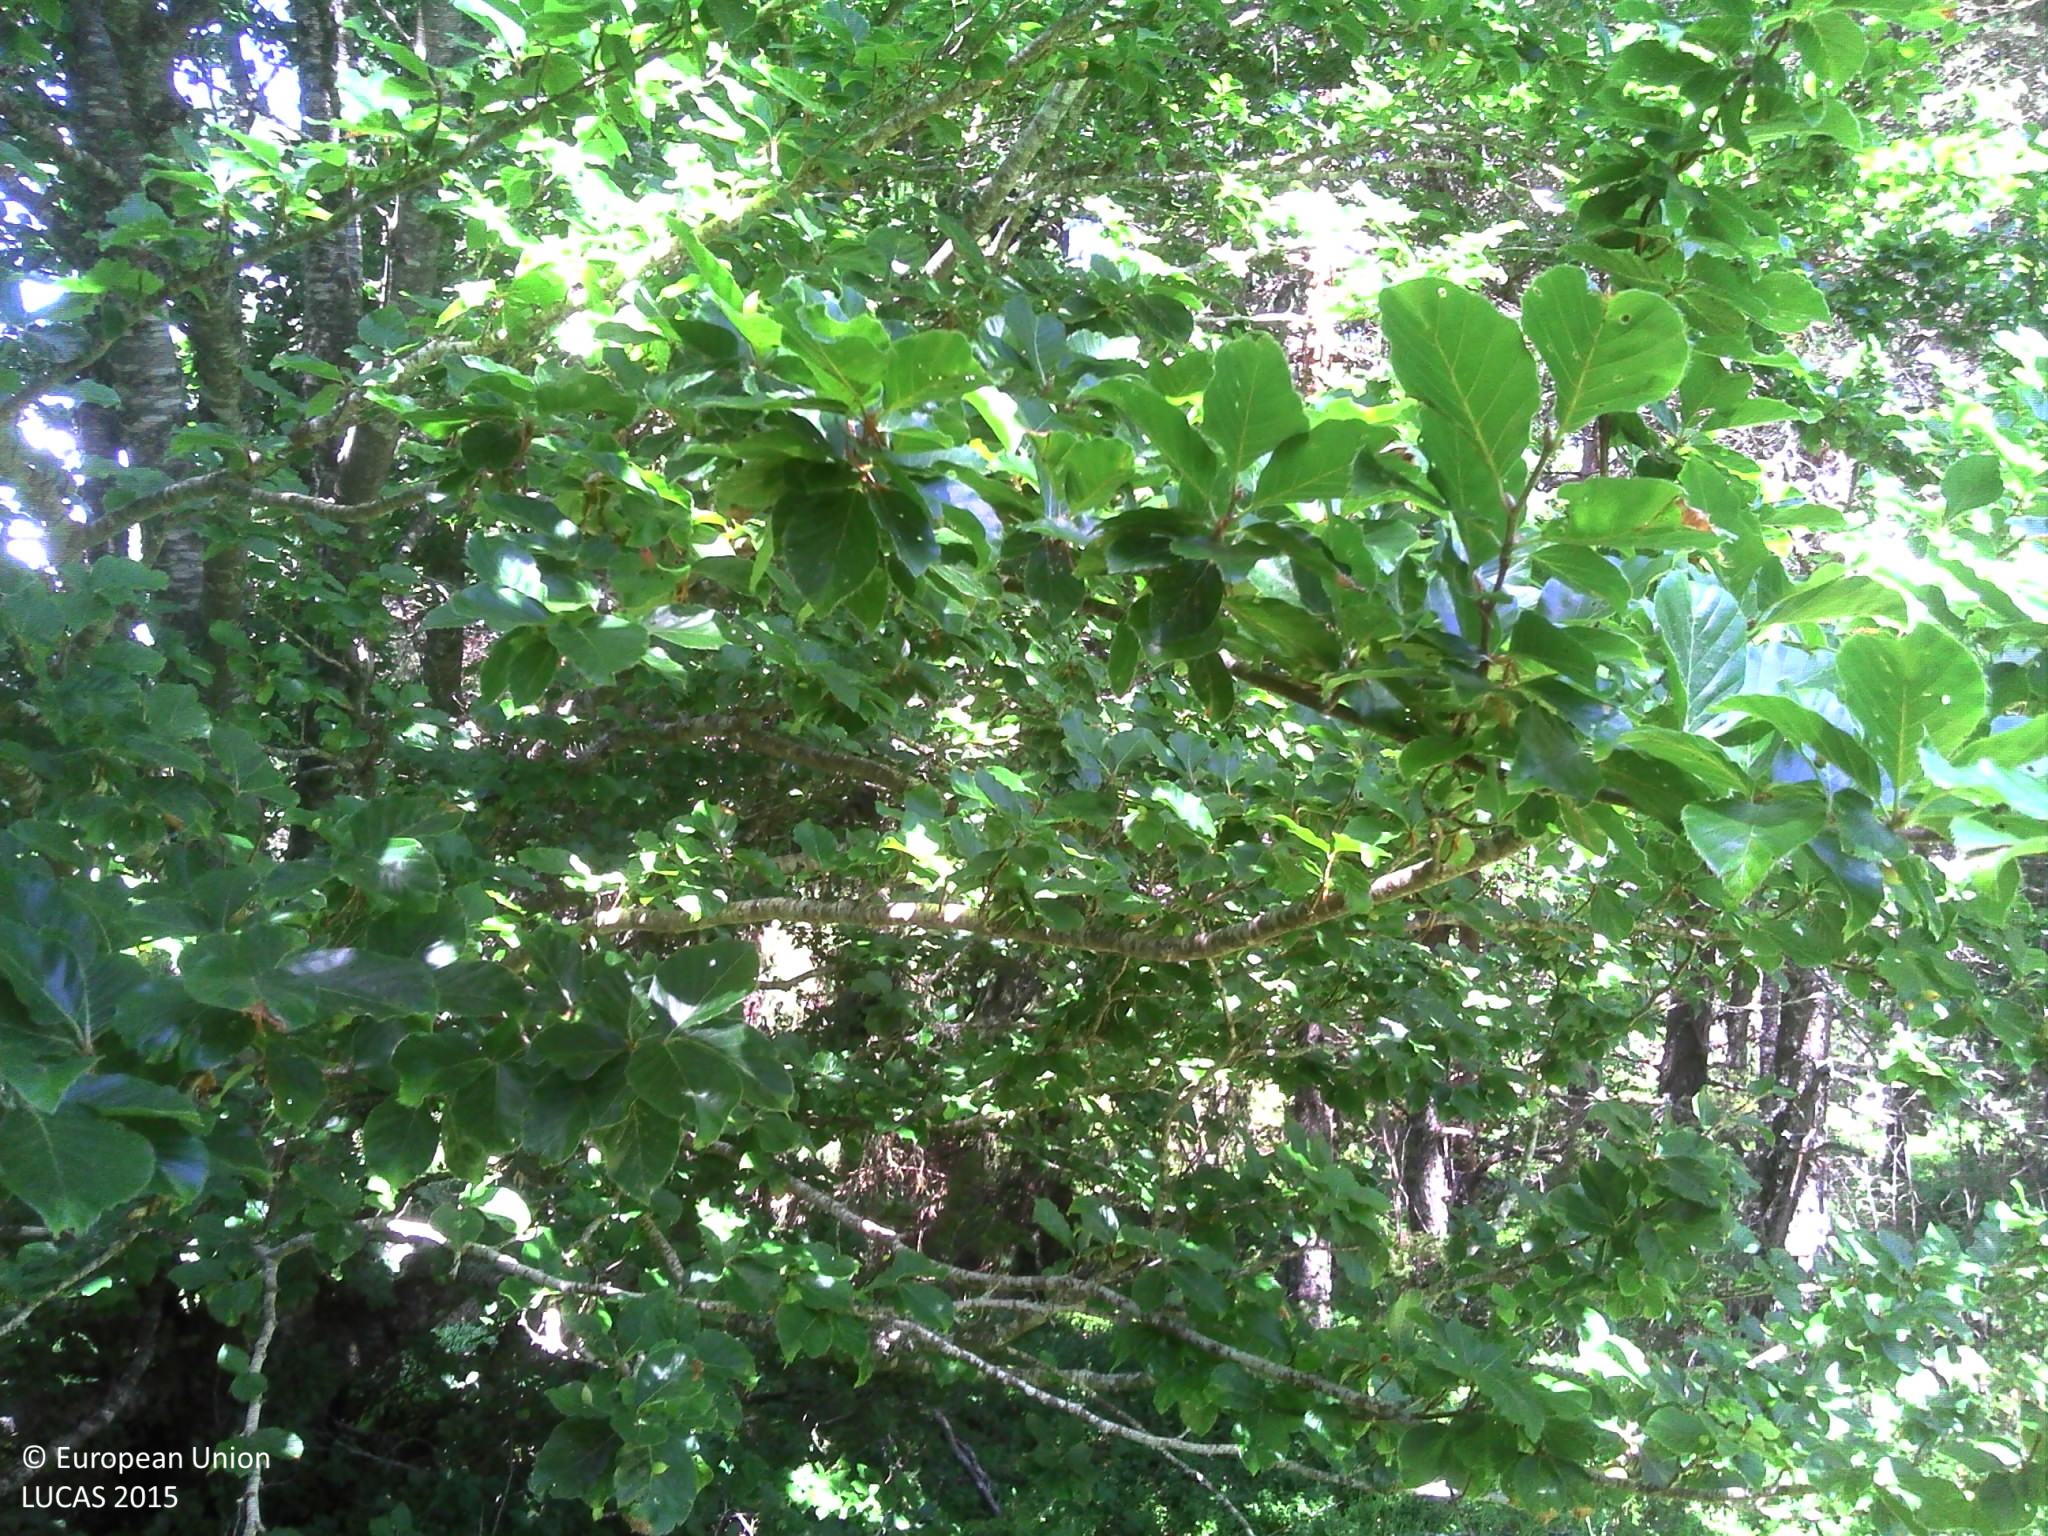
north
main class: Woodland
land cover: Pine dominated mixed woodland
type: mountainous beech forest
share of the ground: 50 - 75 %
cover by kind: herbaceous plants 40 %, broadleaved forest trees 35 %, coniferous forest trees 25 %
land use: Forestry
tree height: > 5 m
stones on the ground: 10 - 25 %
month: June
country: FR
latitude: 44.5788
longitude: 3.4686
